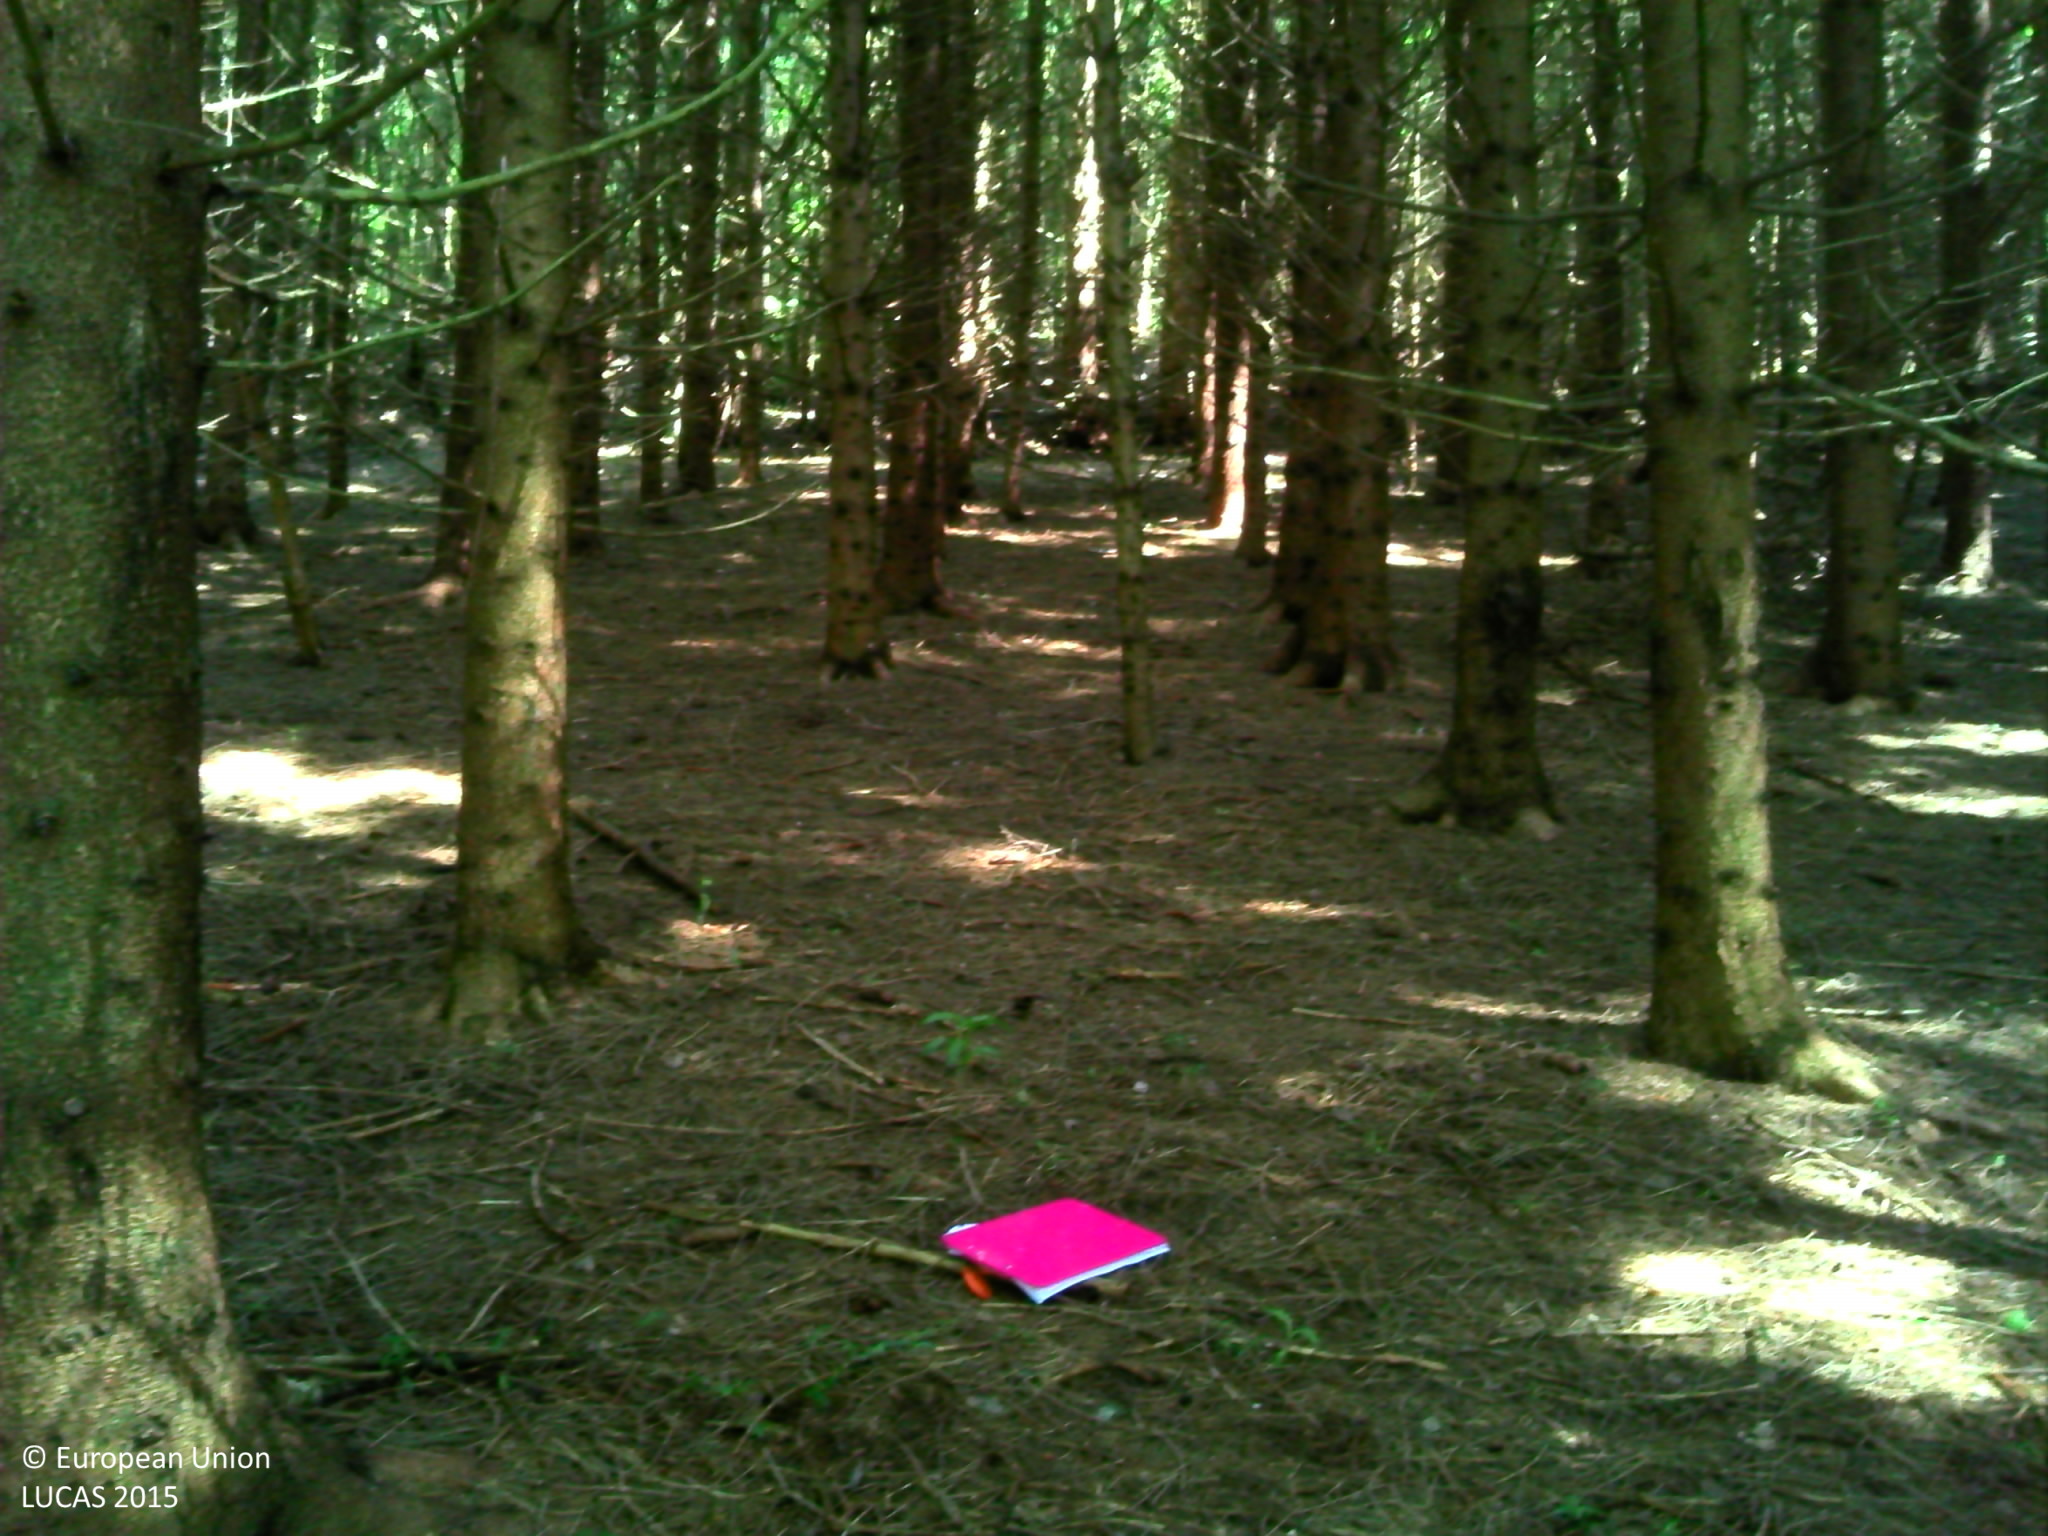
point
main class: Woodland
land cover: Spruce dominated coniferous woodland
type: alpine coniferous forest
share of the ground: > 75 %
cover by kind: coniferous forest trees 100 %
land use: Forestry
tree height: > 5 m
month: June
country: FR
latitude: 45.4894
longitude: 6.1789
